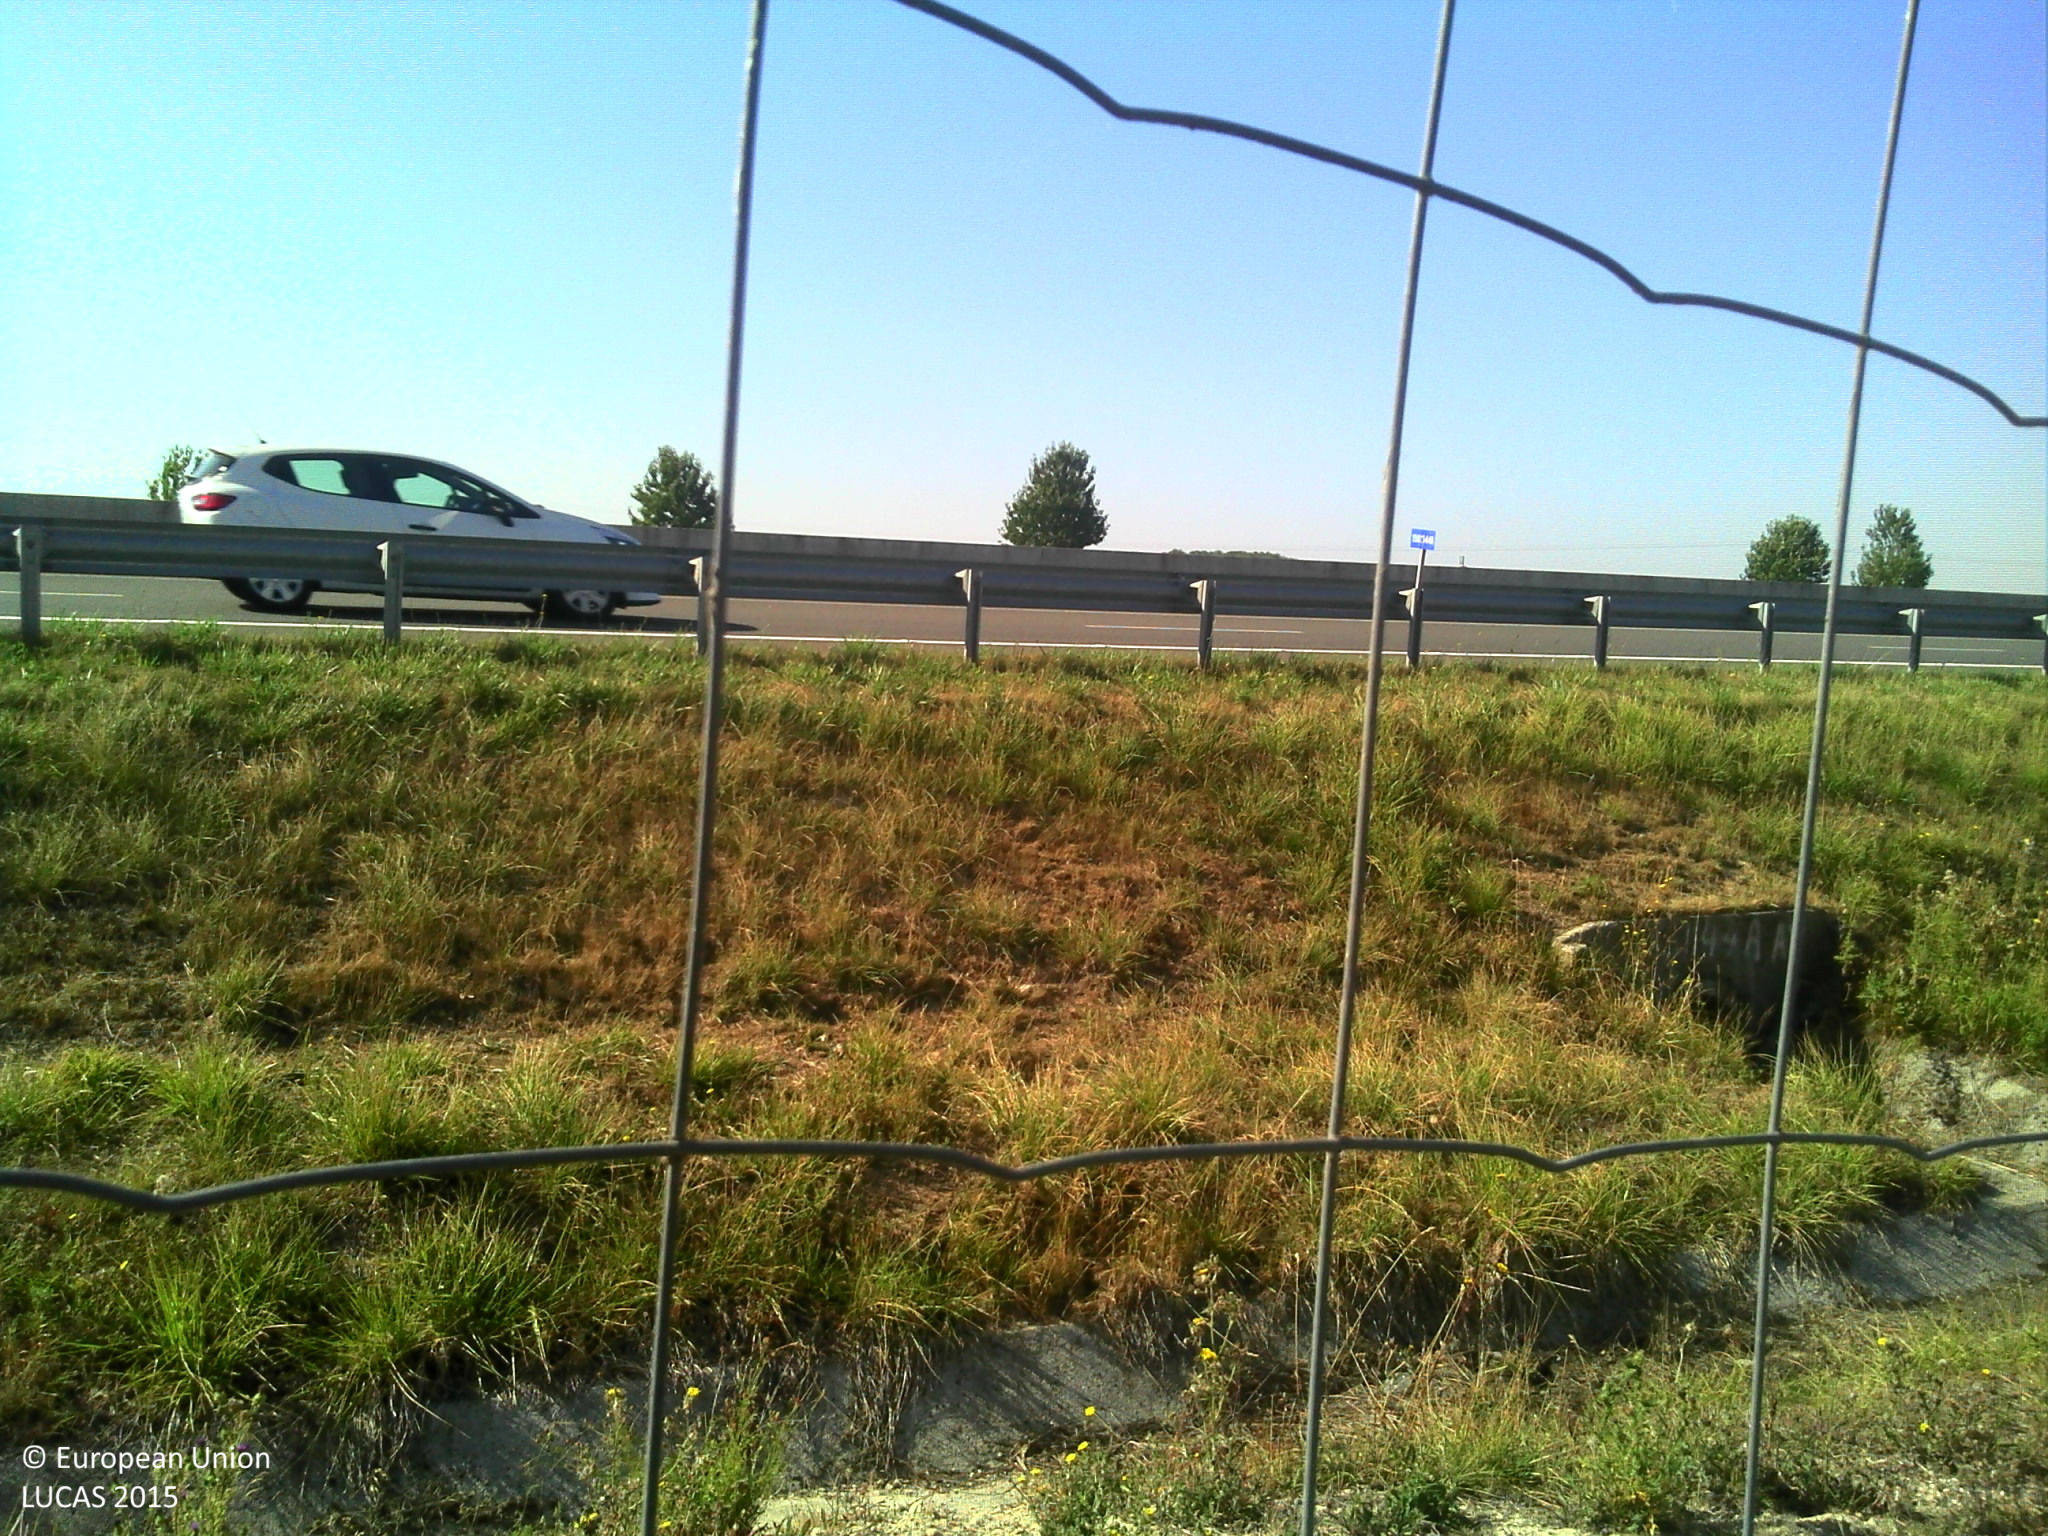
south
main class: Grassland
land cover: Grassland without tree/shrub cover
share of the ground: > 75 %
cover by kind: herbaceous plants 100 %
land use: Road transport
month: August
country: FR
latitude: 48.0971
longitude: 2.0250
